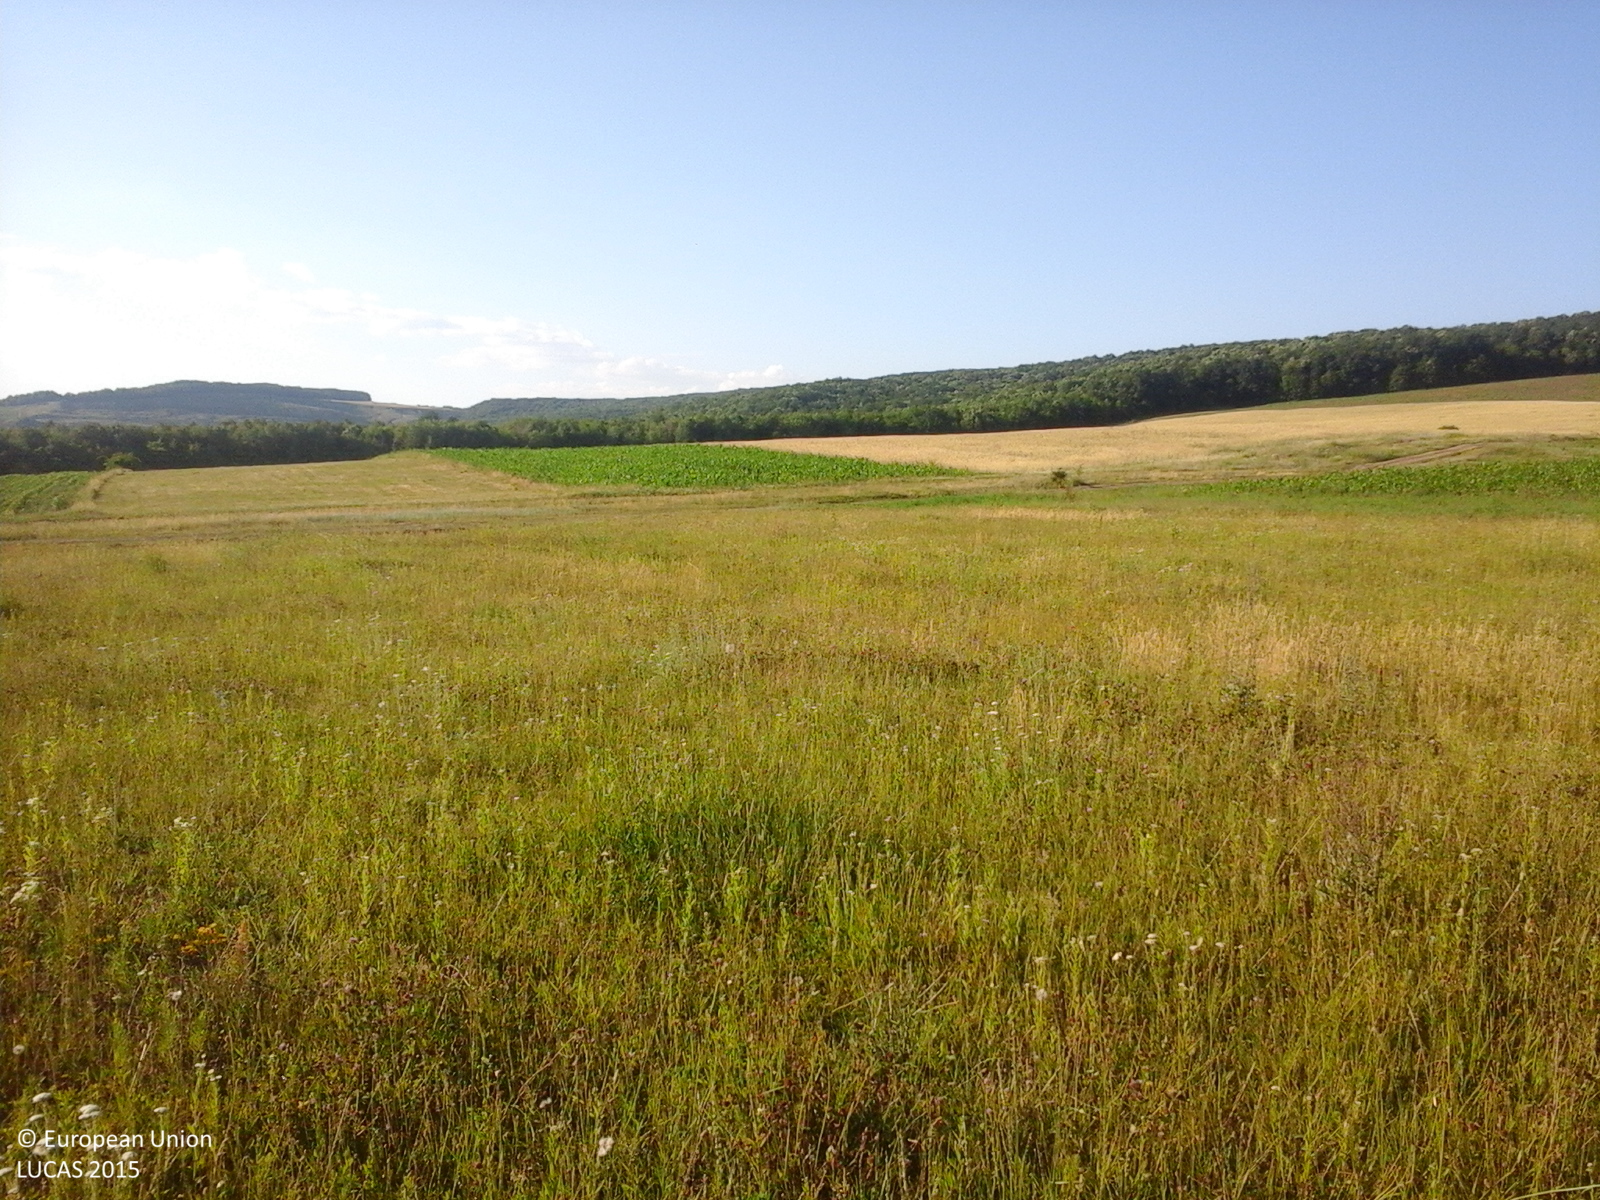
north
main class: Grassland
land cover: Grassland without tree/shrub cover
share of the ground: > 75 %
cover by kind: herbaceous plants 100 %
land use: Agriculture (excluding fallow land and kitchen gardens)
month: June
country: RO
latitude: 46.9774
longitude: 27.3706
